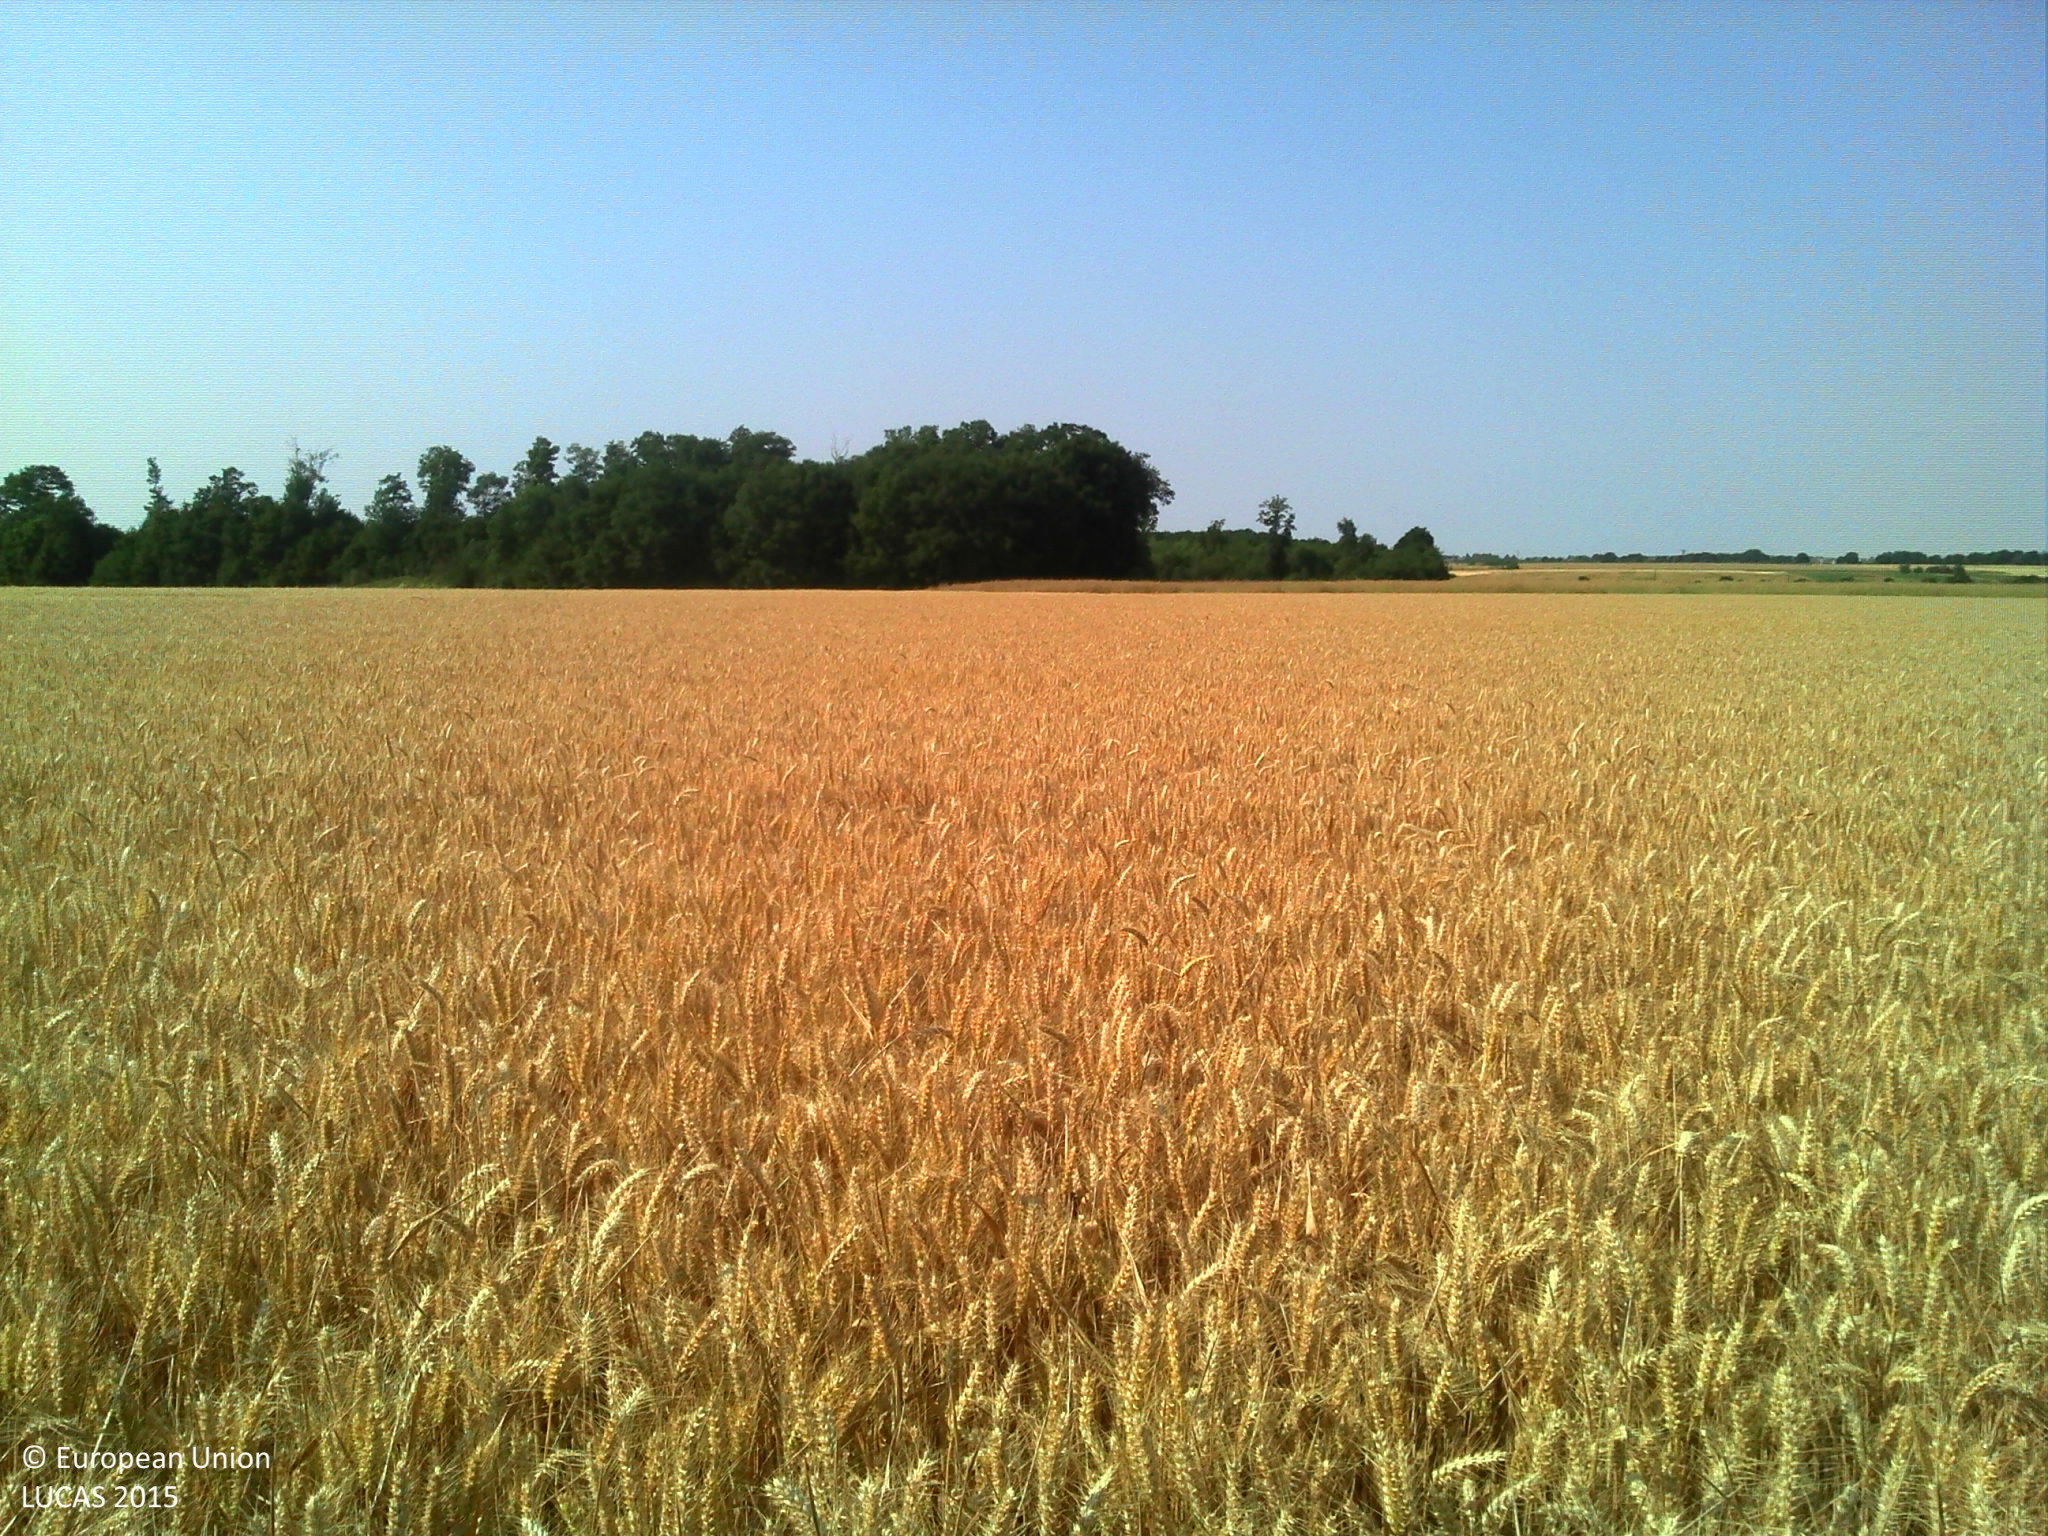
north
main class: Cropland
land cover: Common wheat
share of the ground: > 75 %
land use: Agriculture (excluding fallow land and kitchen gardens)
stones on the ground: < 10 %
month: July
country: FR
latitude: 48.8719
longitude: 1.2687
